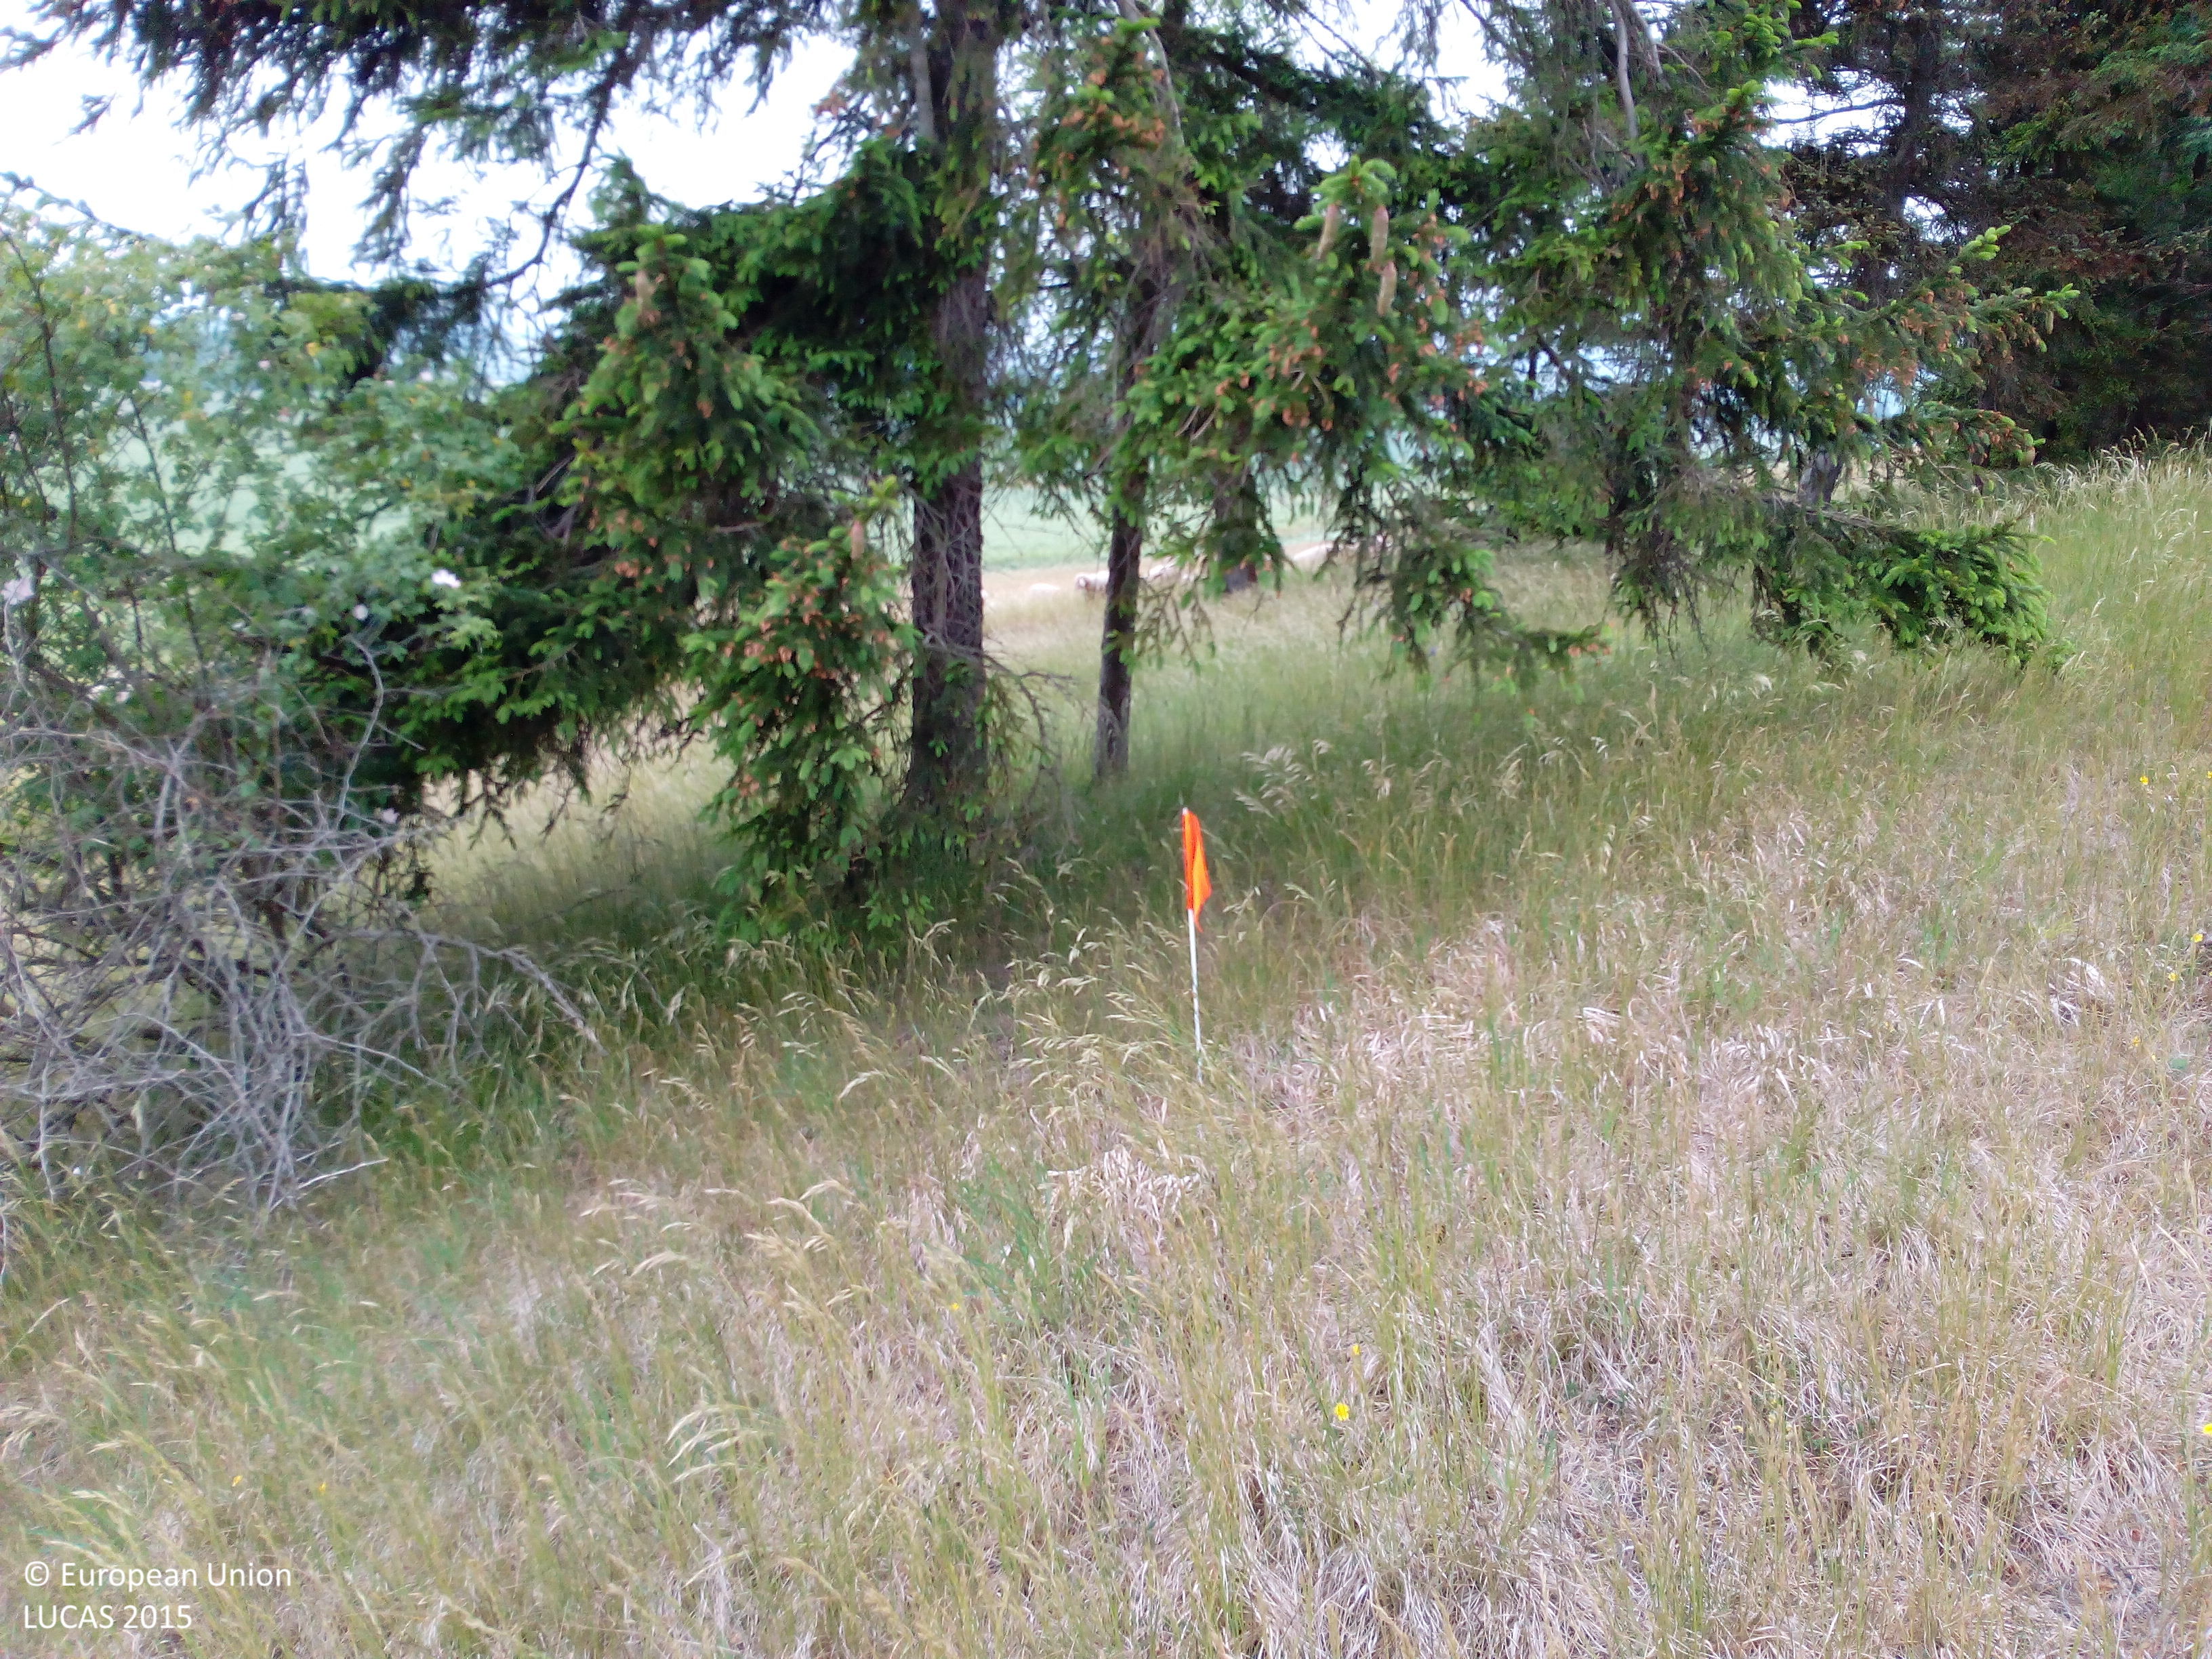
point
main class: Woodland
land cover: Spruce dominated coniferous woodland
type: hemiboreal forest and nemoral coniferous forest and mixed broadleaved-coniferous forest
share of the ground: 10 - 25 %
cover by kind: herbaceous plants 80 %, coniferous forest trees 15 %, shrubs 5 %
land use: Agriculture (excluding fallow land and kitchen gardens)
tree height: > 5 m
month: June
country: DE
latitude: 50.9915
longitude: 10.6409
